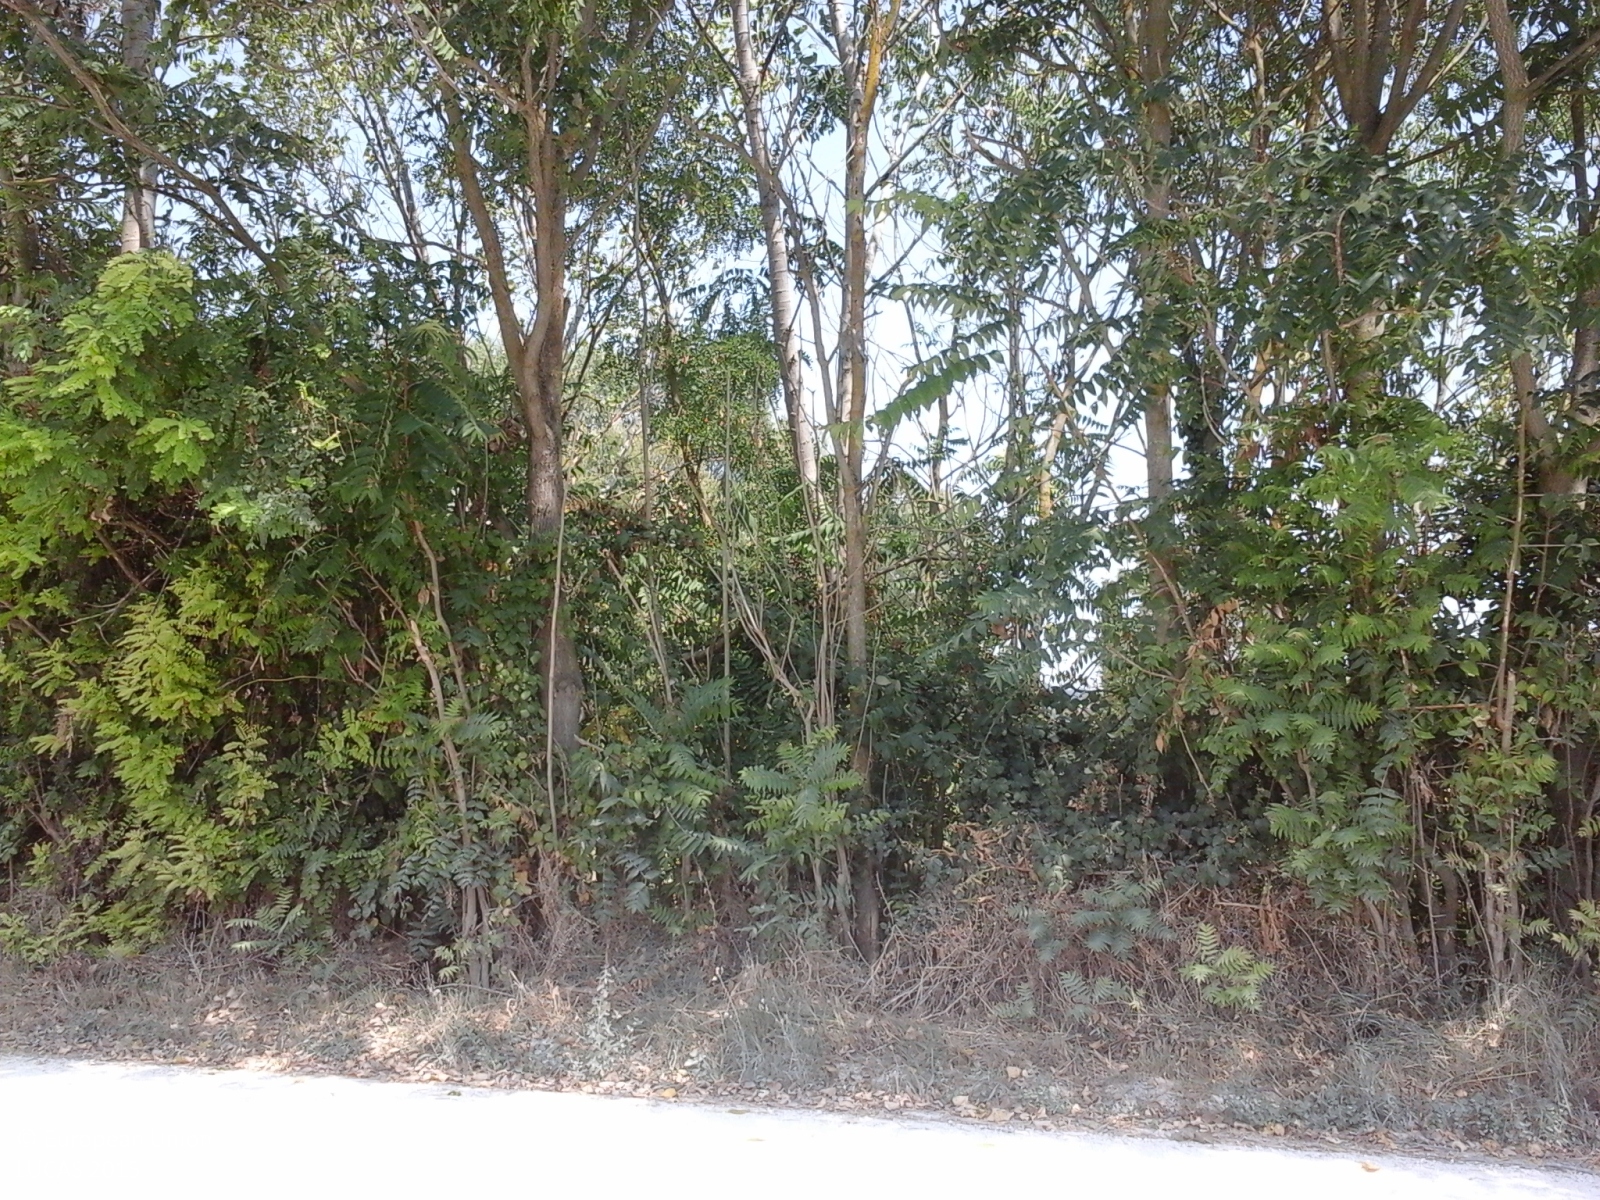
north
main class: Cropland
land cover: Sunflower
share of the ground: > 75 %
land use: Agriculture (excluding fallow land and kitchen gardens)
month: August
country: IT
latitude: 43.4621
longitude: 13.4646
